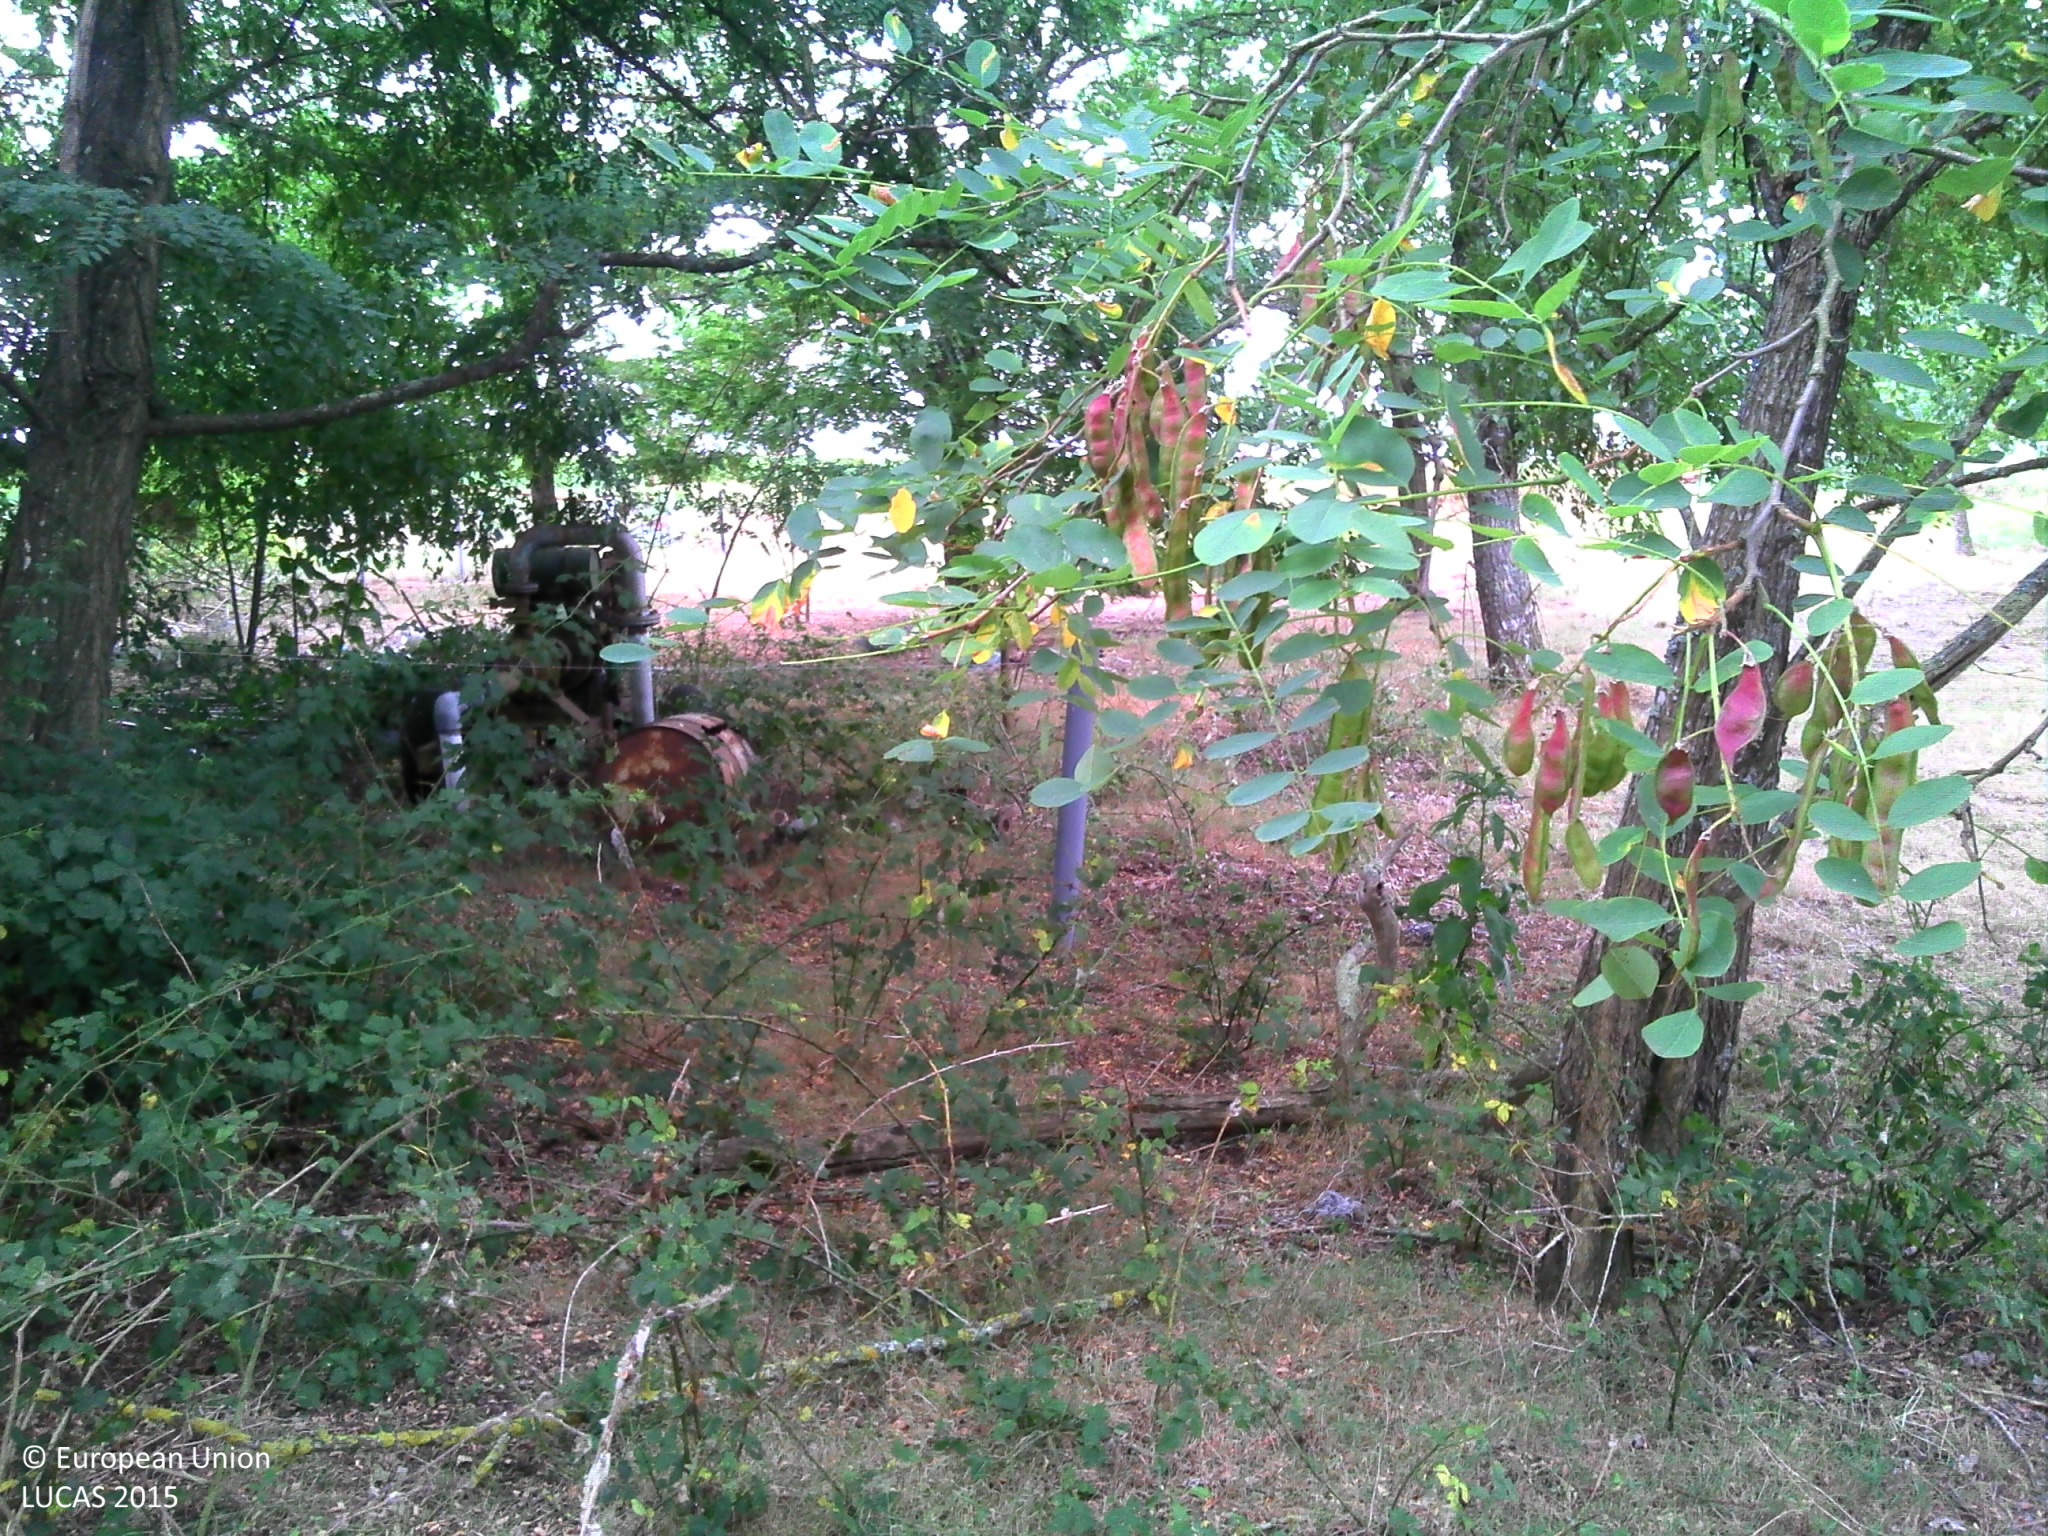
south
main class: Grassland
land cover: Grassland with sparse tree/shrub cover
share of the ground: > 75 %
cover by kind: herbaceous plants 95 %, broadleaved forest trees 5 %
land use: Residential
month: July
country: FR
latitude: 44.0896
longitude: -0.8449
